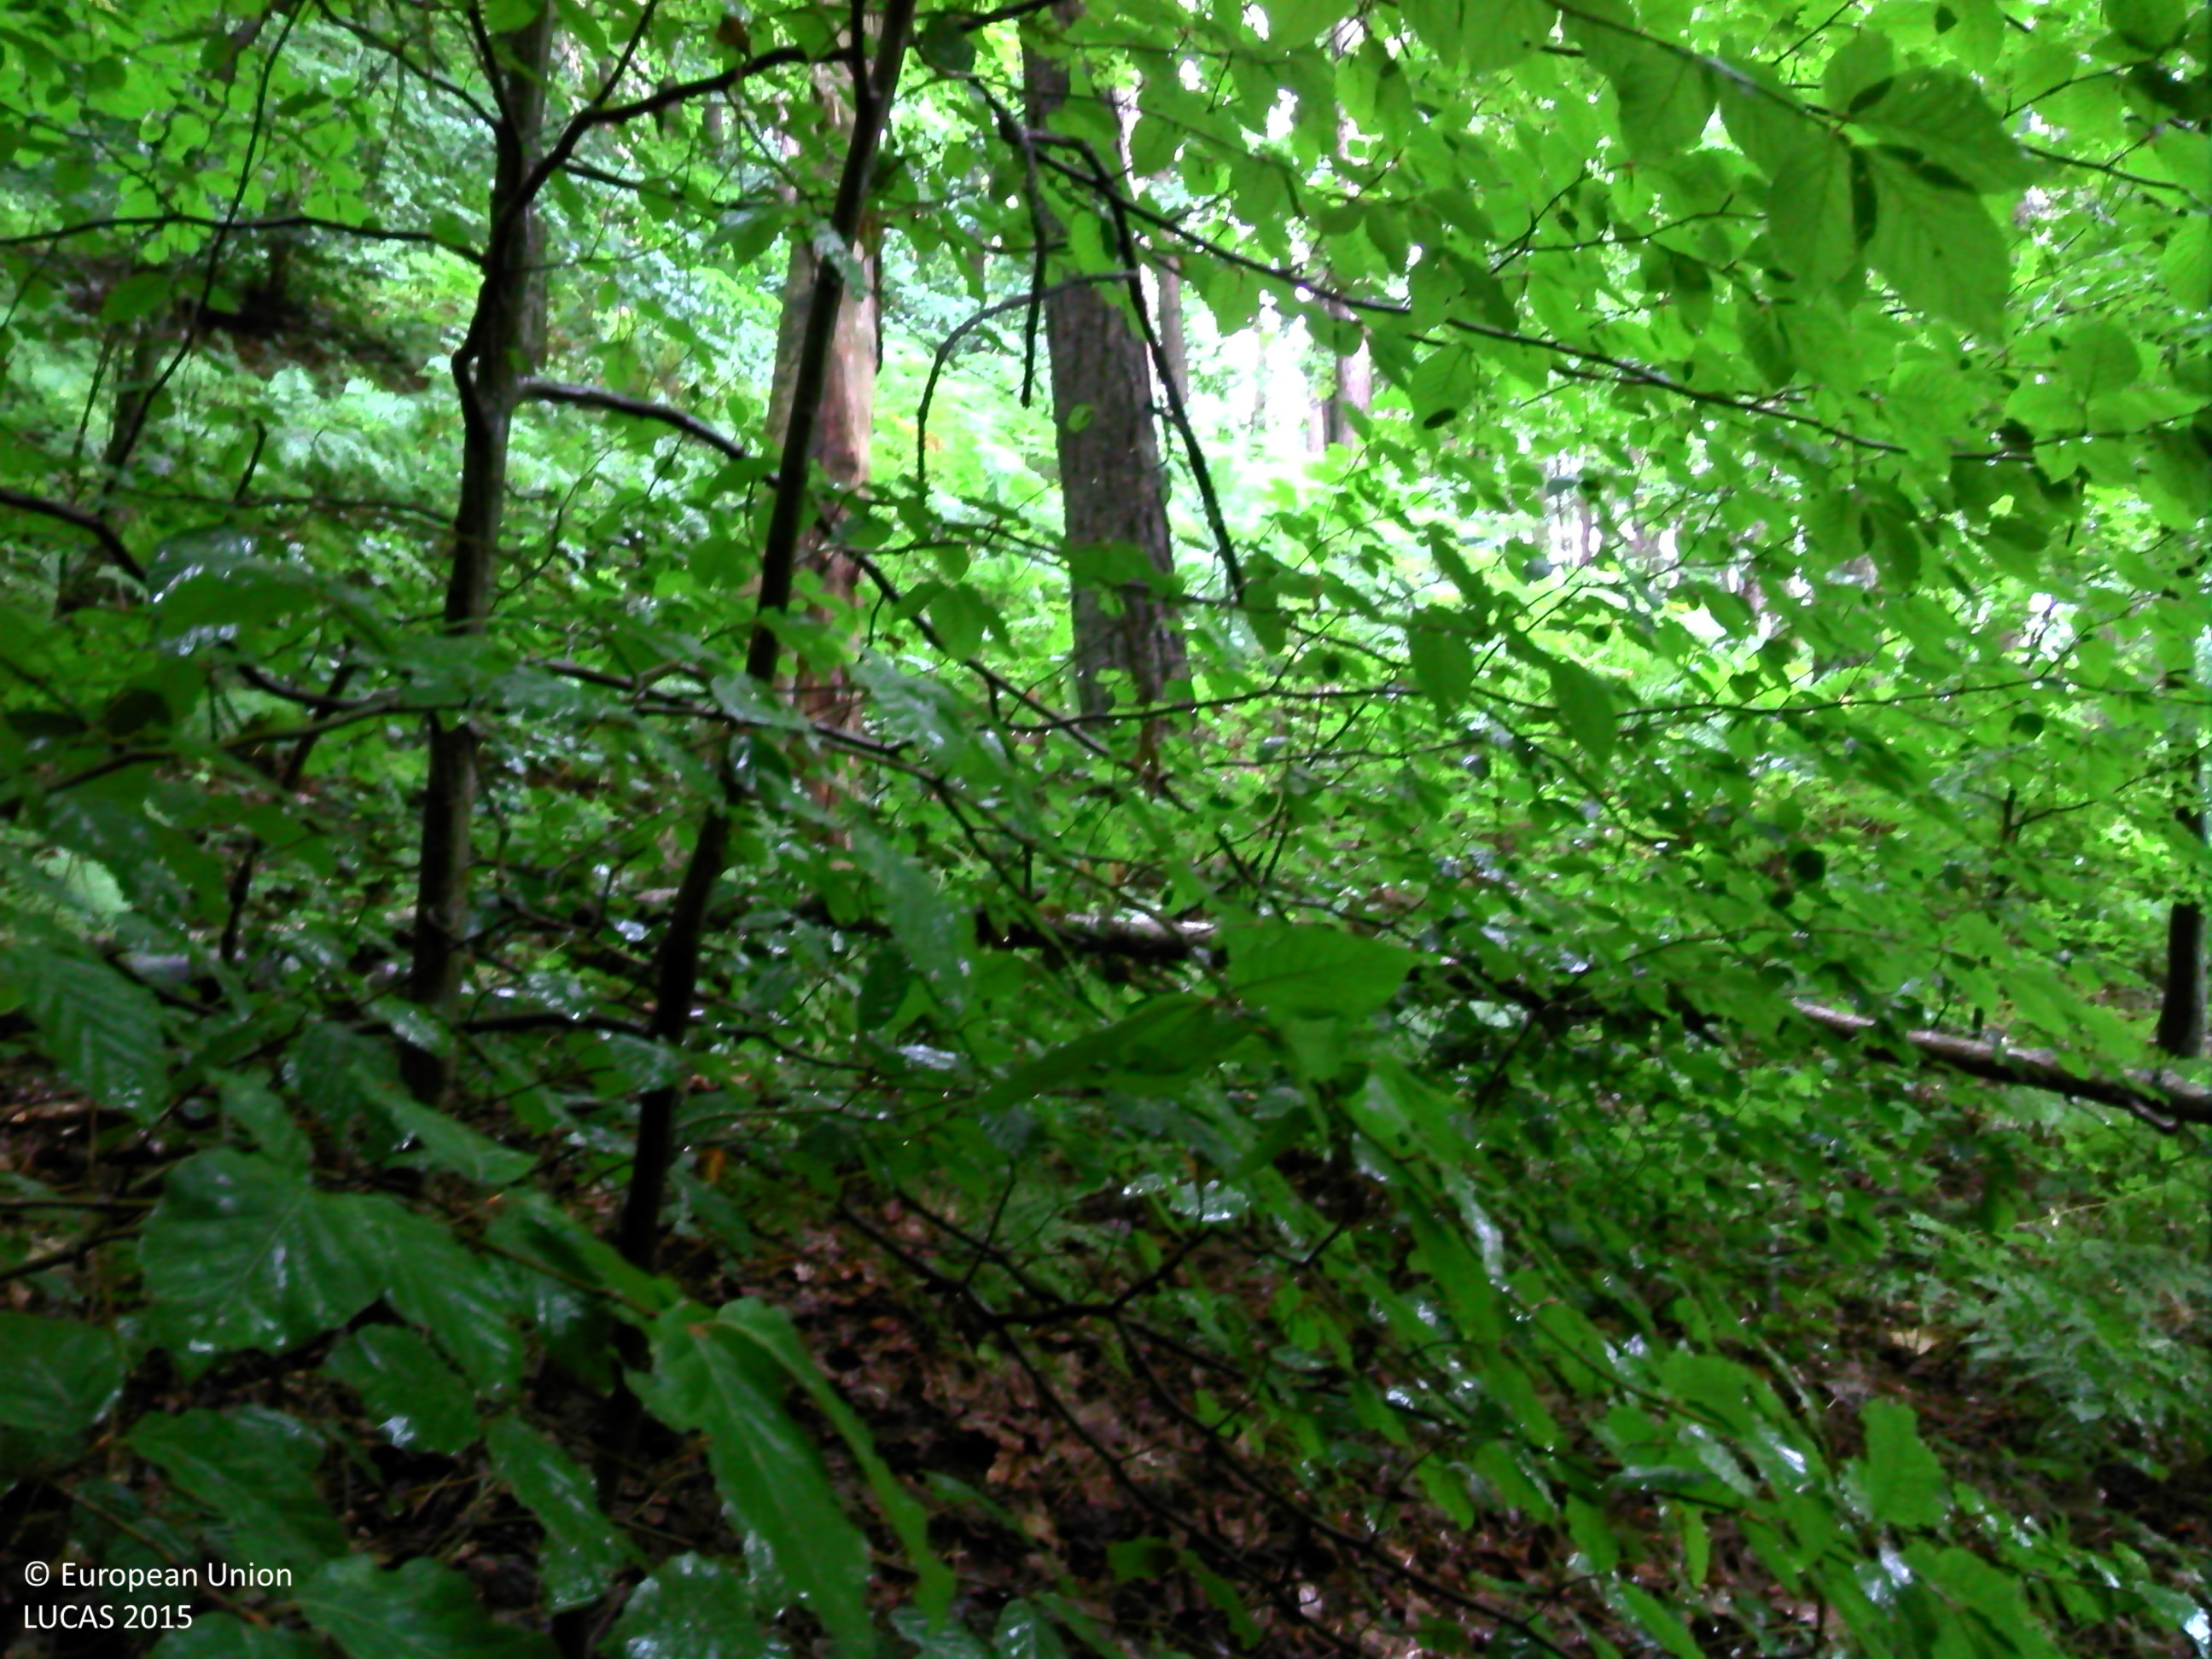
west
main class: Woodland
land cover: Broadleaved woodland
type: acidophilous oak and oak-birch forest
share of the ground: > 75 %
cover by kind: broadleaved forest trees 95 %, herbaceous plants 5 %
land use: Forestry
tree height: > 5 m
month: July
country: BE
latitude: 50.5197
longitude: 5.3011
